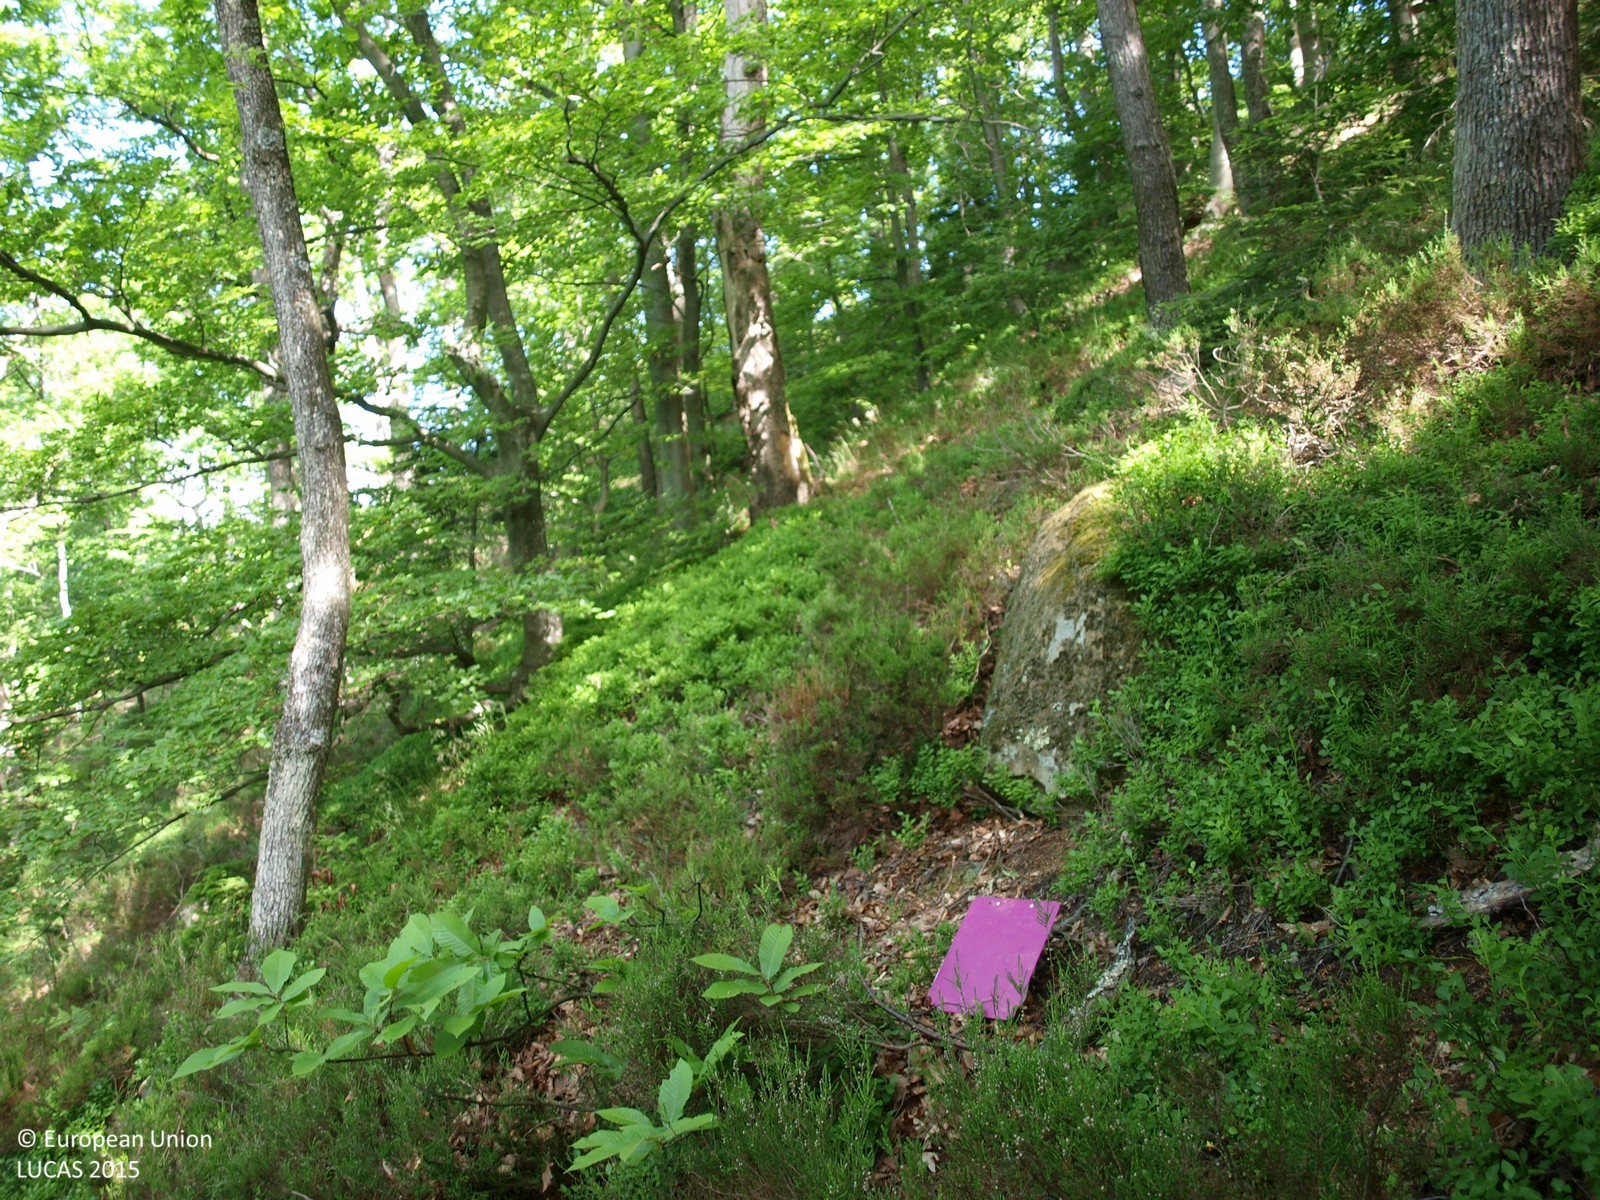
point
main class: Woodland
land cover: Broadleaved woodland
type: mesophytic deciduous forest
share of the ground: > 75 %
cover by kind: broadleaved forest trees 100 %
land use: Forestry
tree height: > 5 m
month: May
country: HR
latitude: 46.2605
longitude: 15.9018
